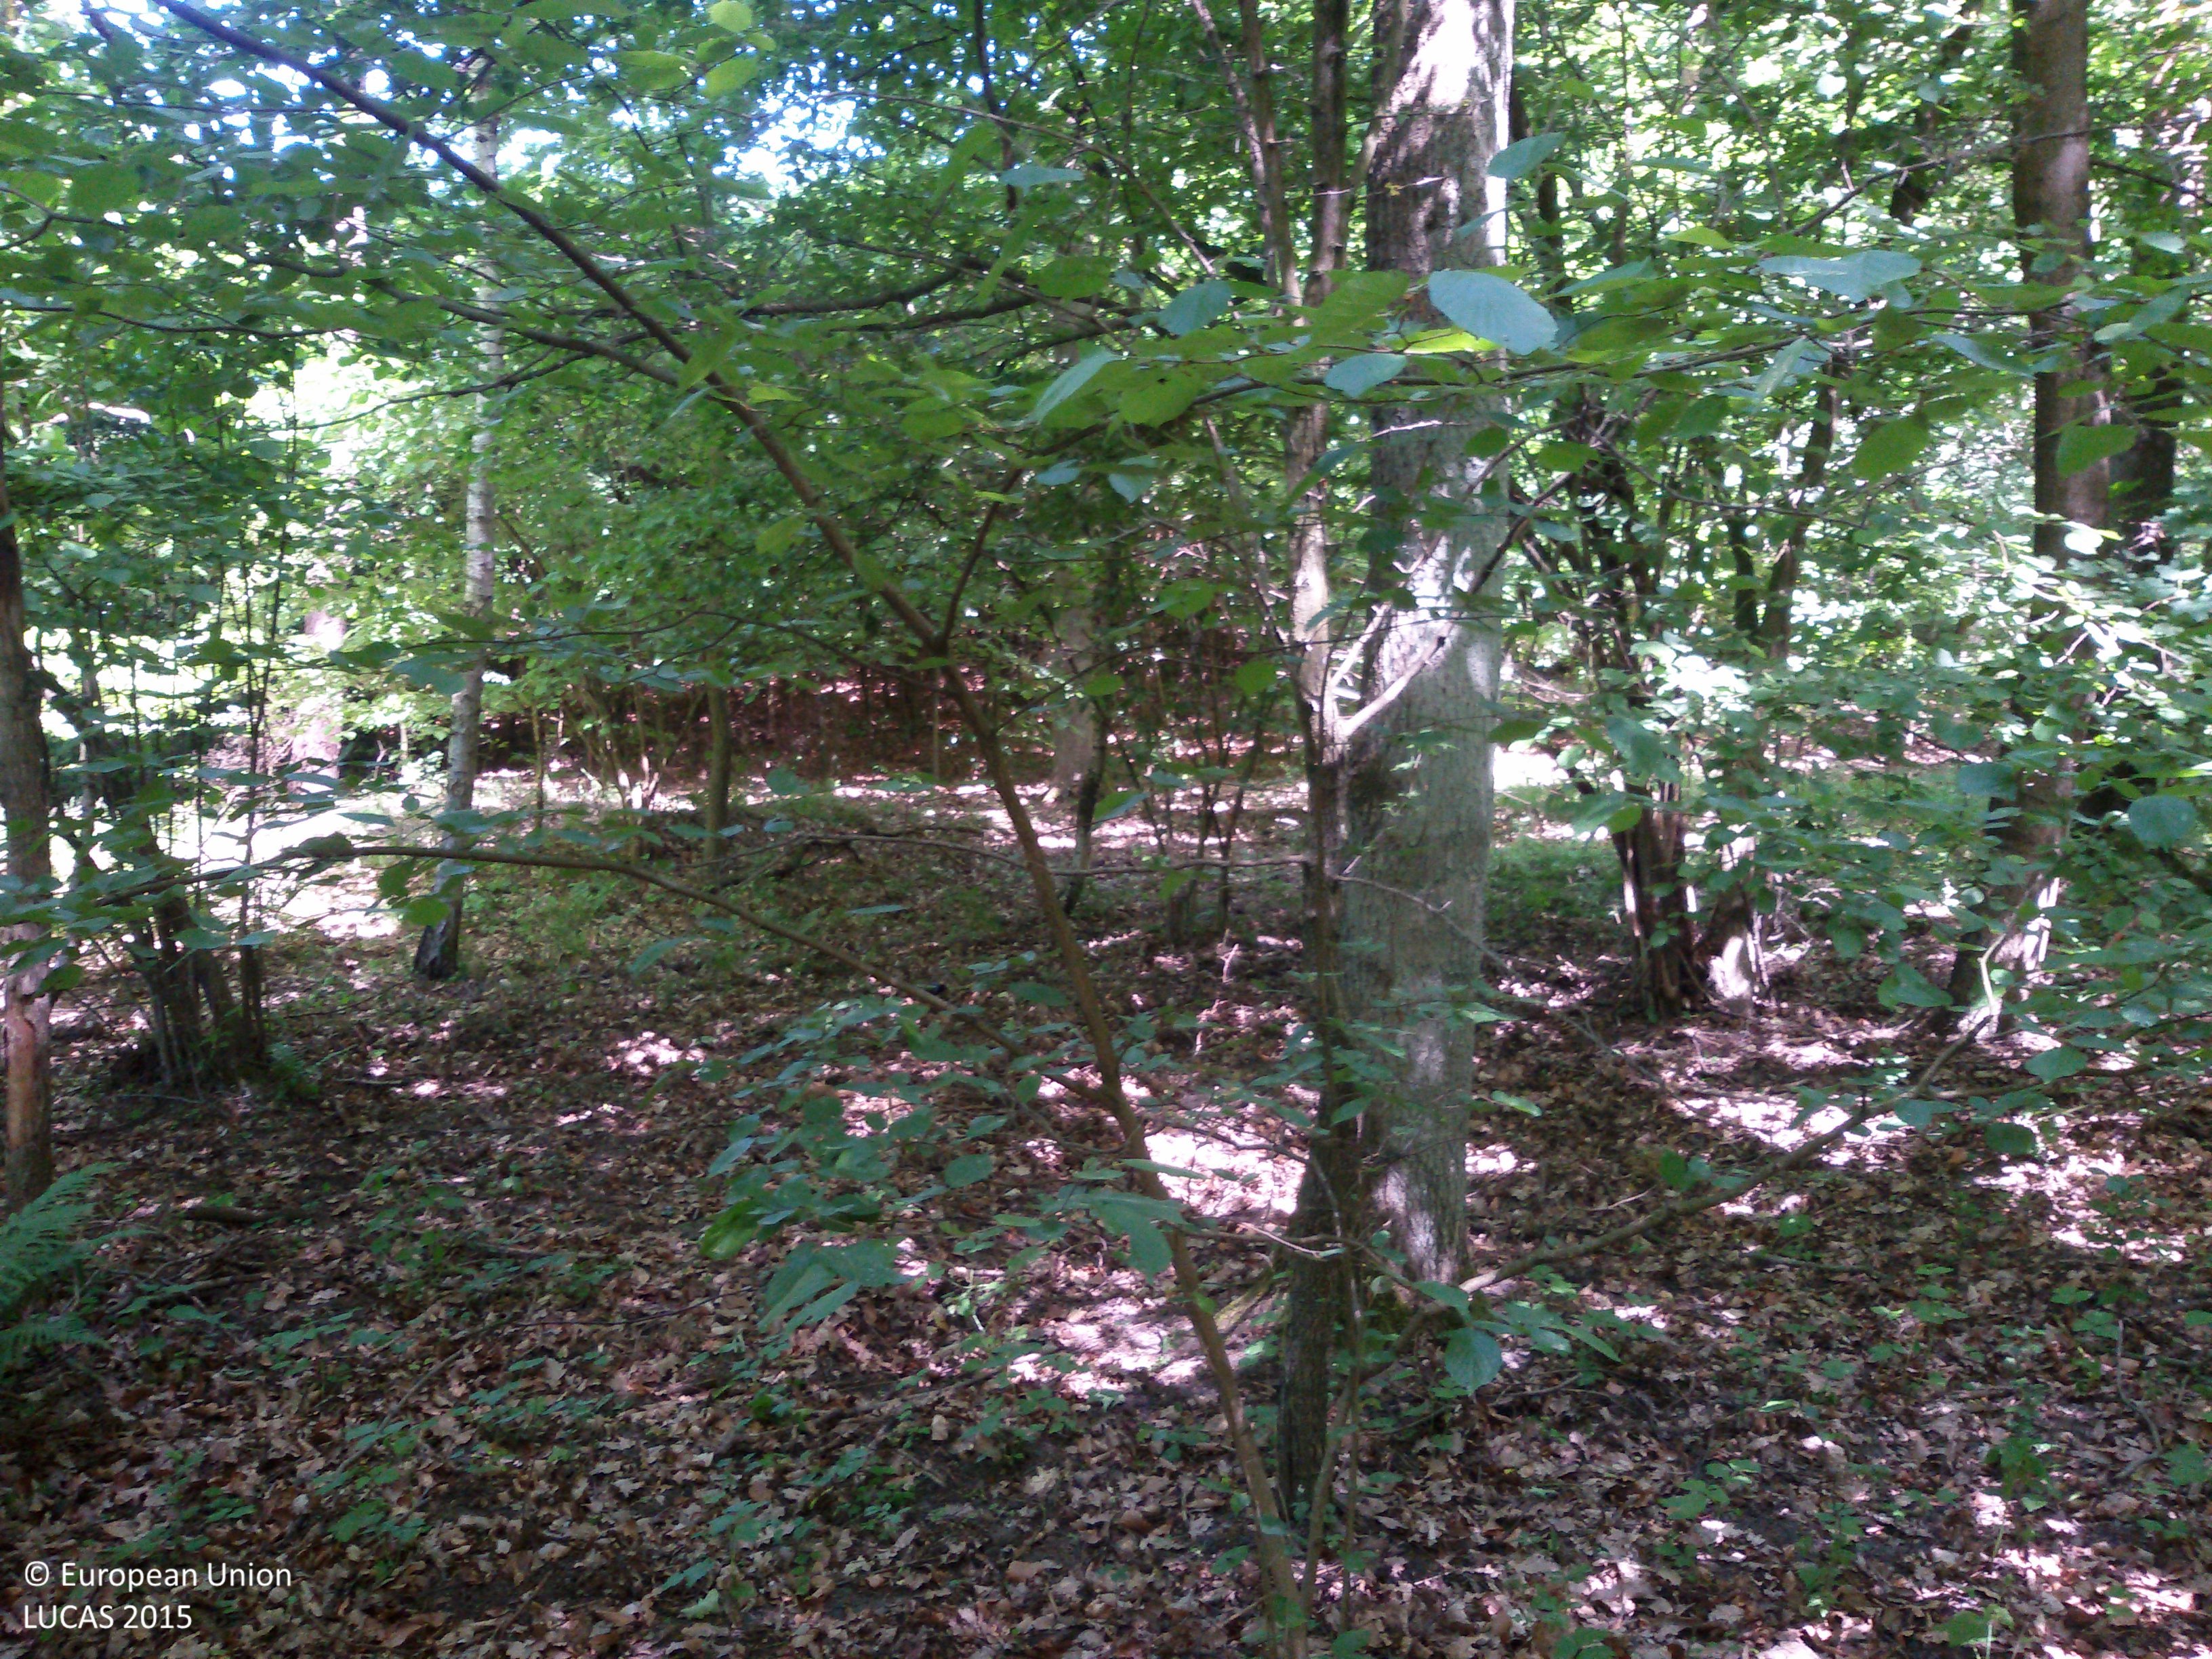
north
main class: Woodland
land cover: Broadleaved woodland
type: mesophytic deciduous forest
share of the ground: > 75 %
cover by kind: broadleaved forest trees 80 %, shrubs 10 %, herbaceous plants 10 %
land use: Forestry
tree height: > 5 m
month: June
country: PL
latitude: 53.2925
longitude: 17.2566
